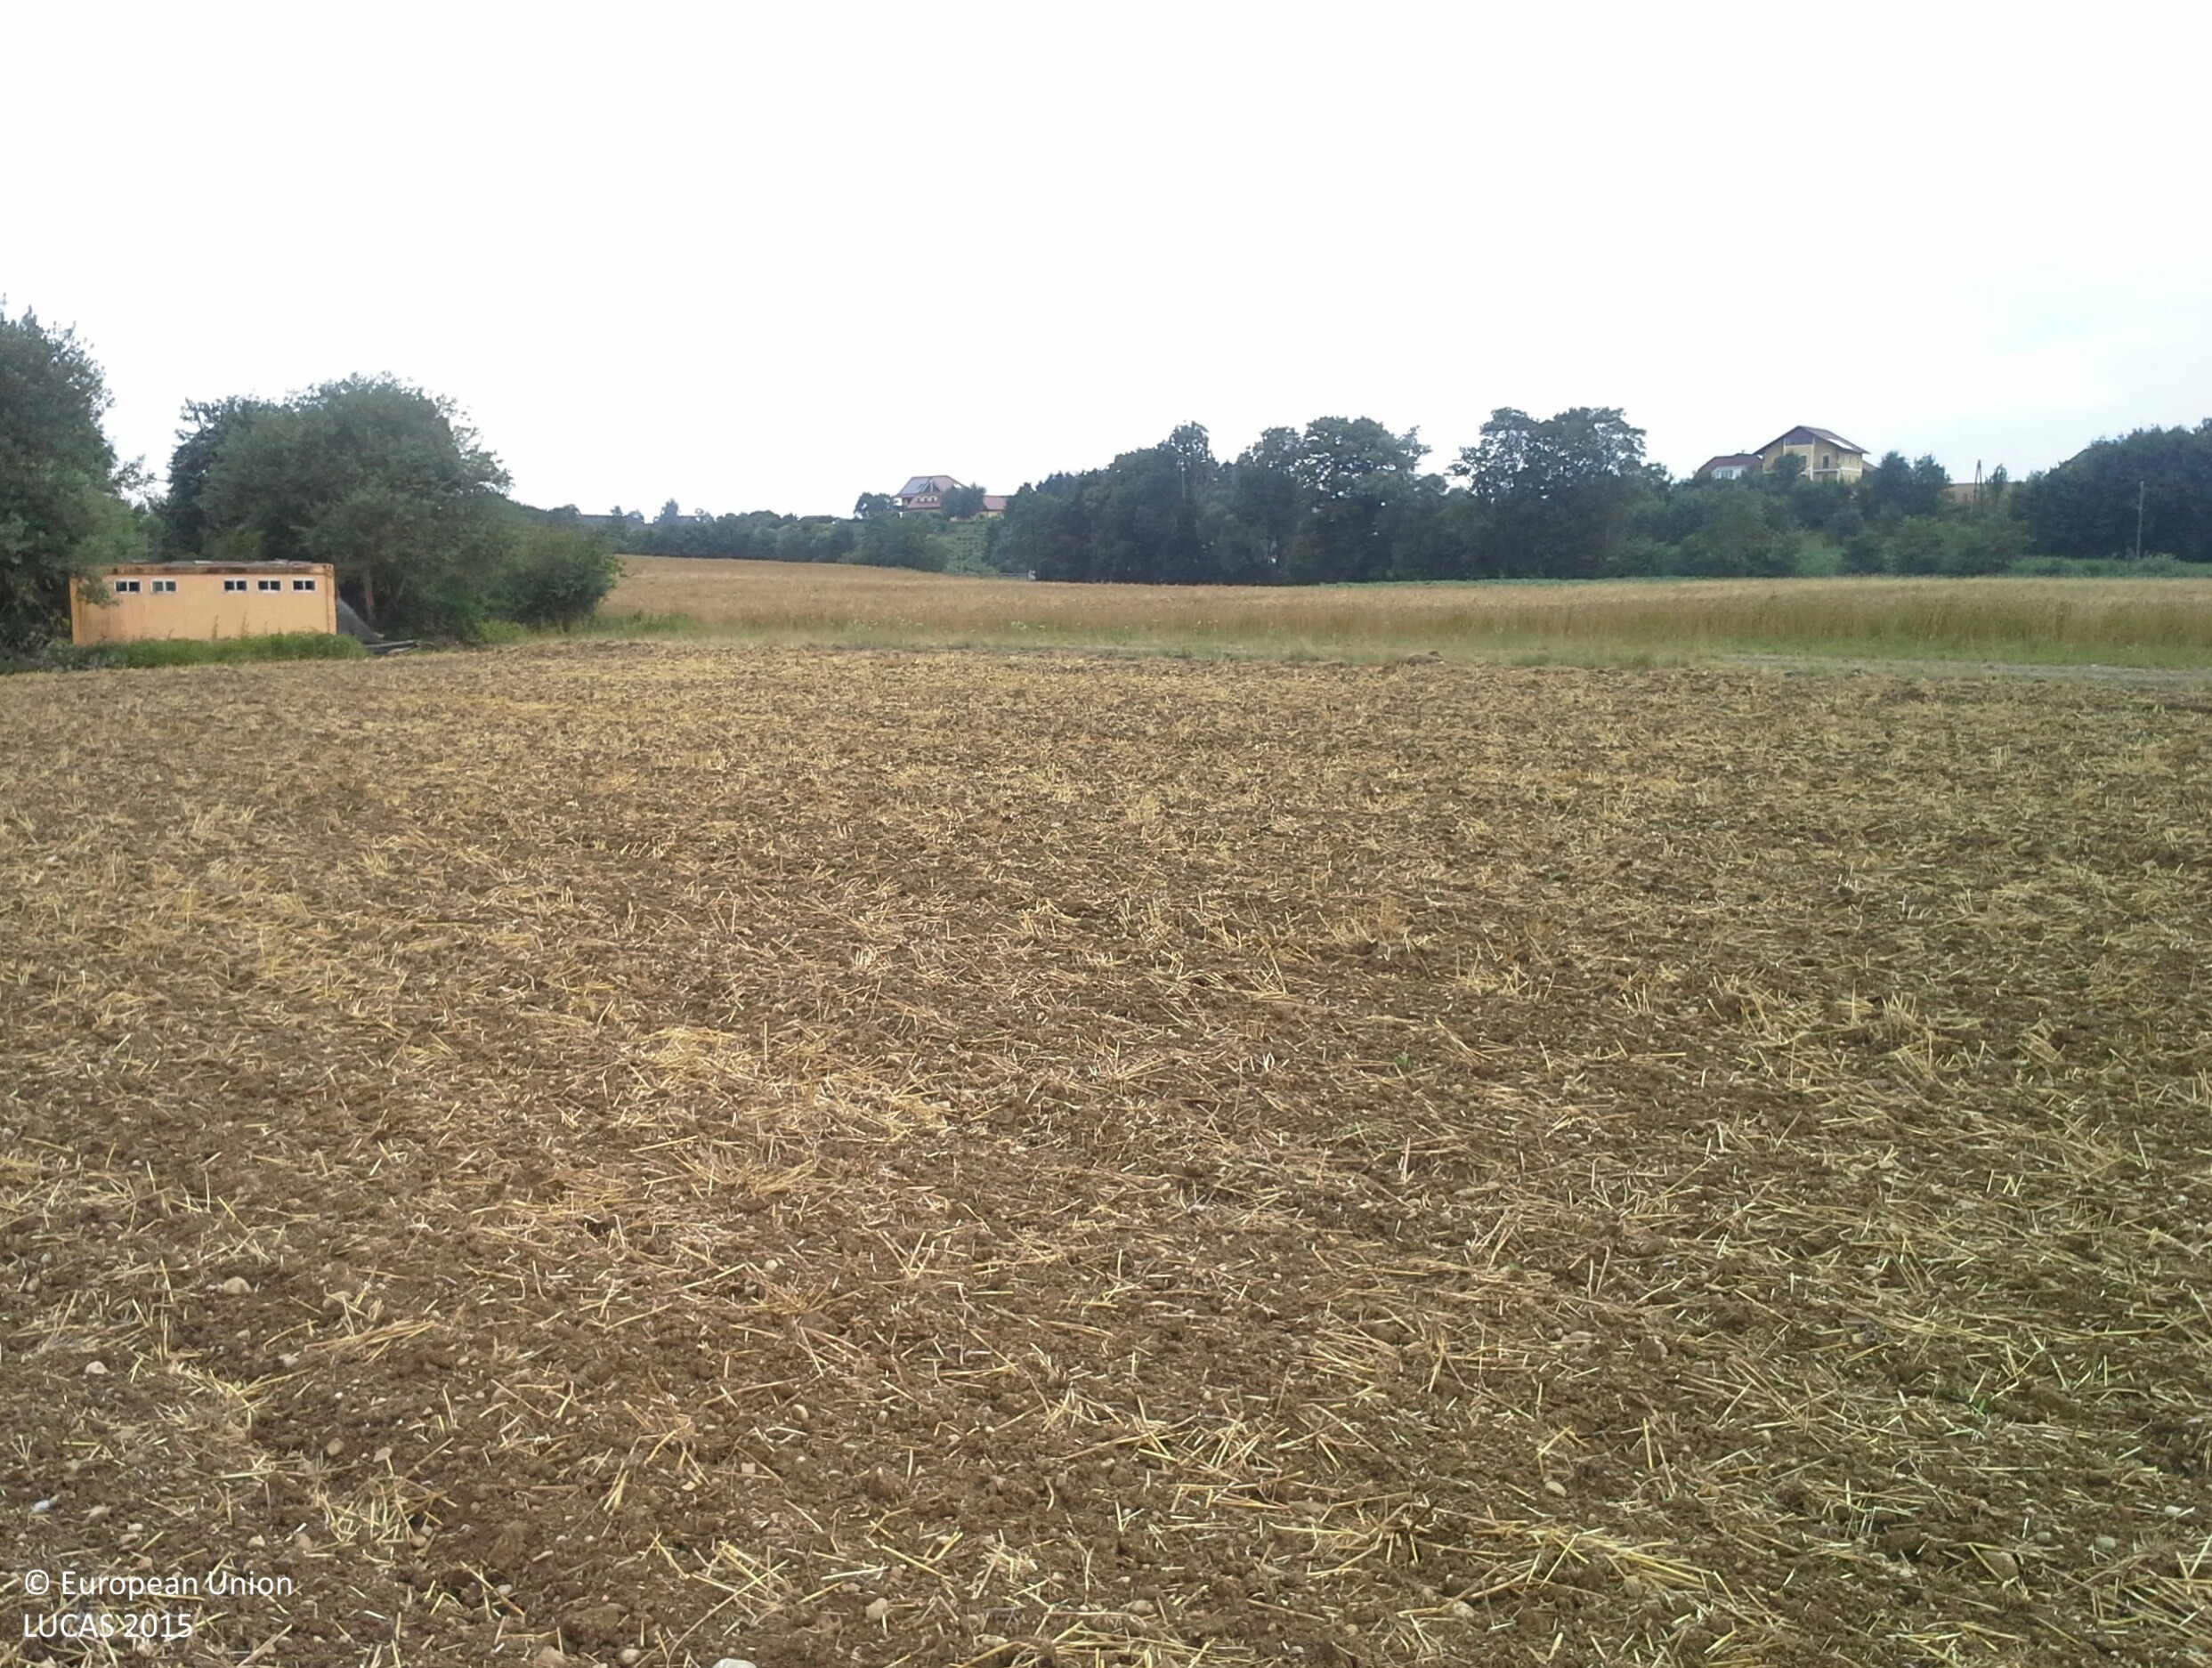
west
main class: Cropland
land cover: Barley
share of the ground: 10 - 25 %
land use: Agriculture (excluding fallow land and kitchen gardens)
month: July
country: AT
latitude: 48.0630
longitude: 14.8449
